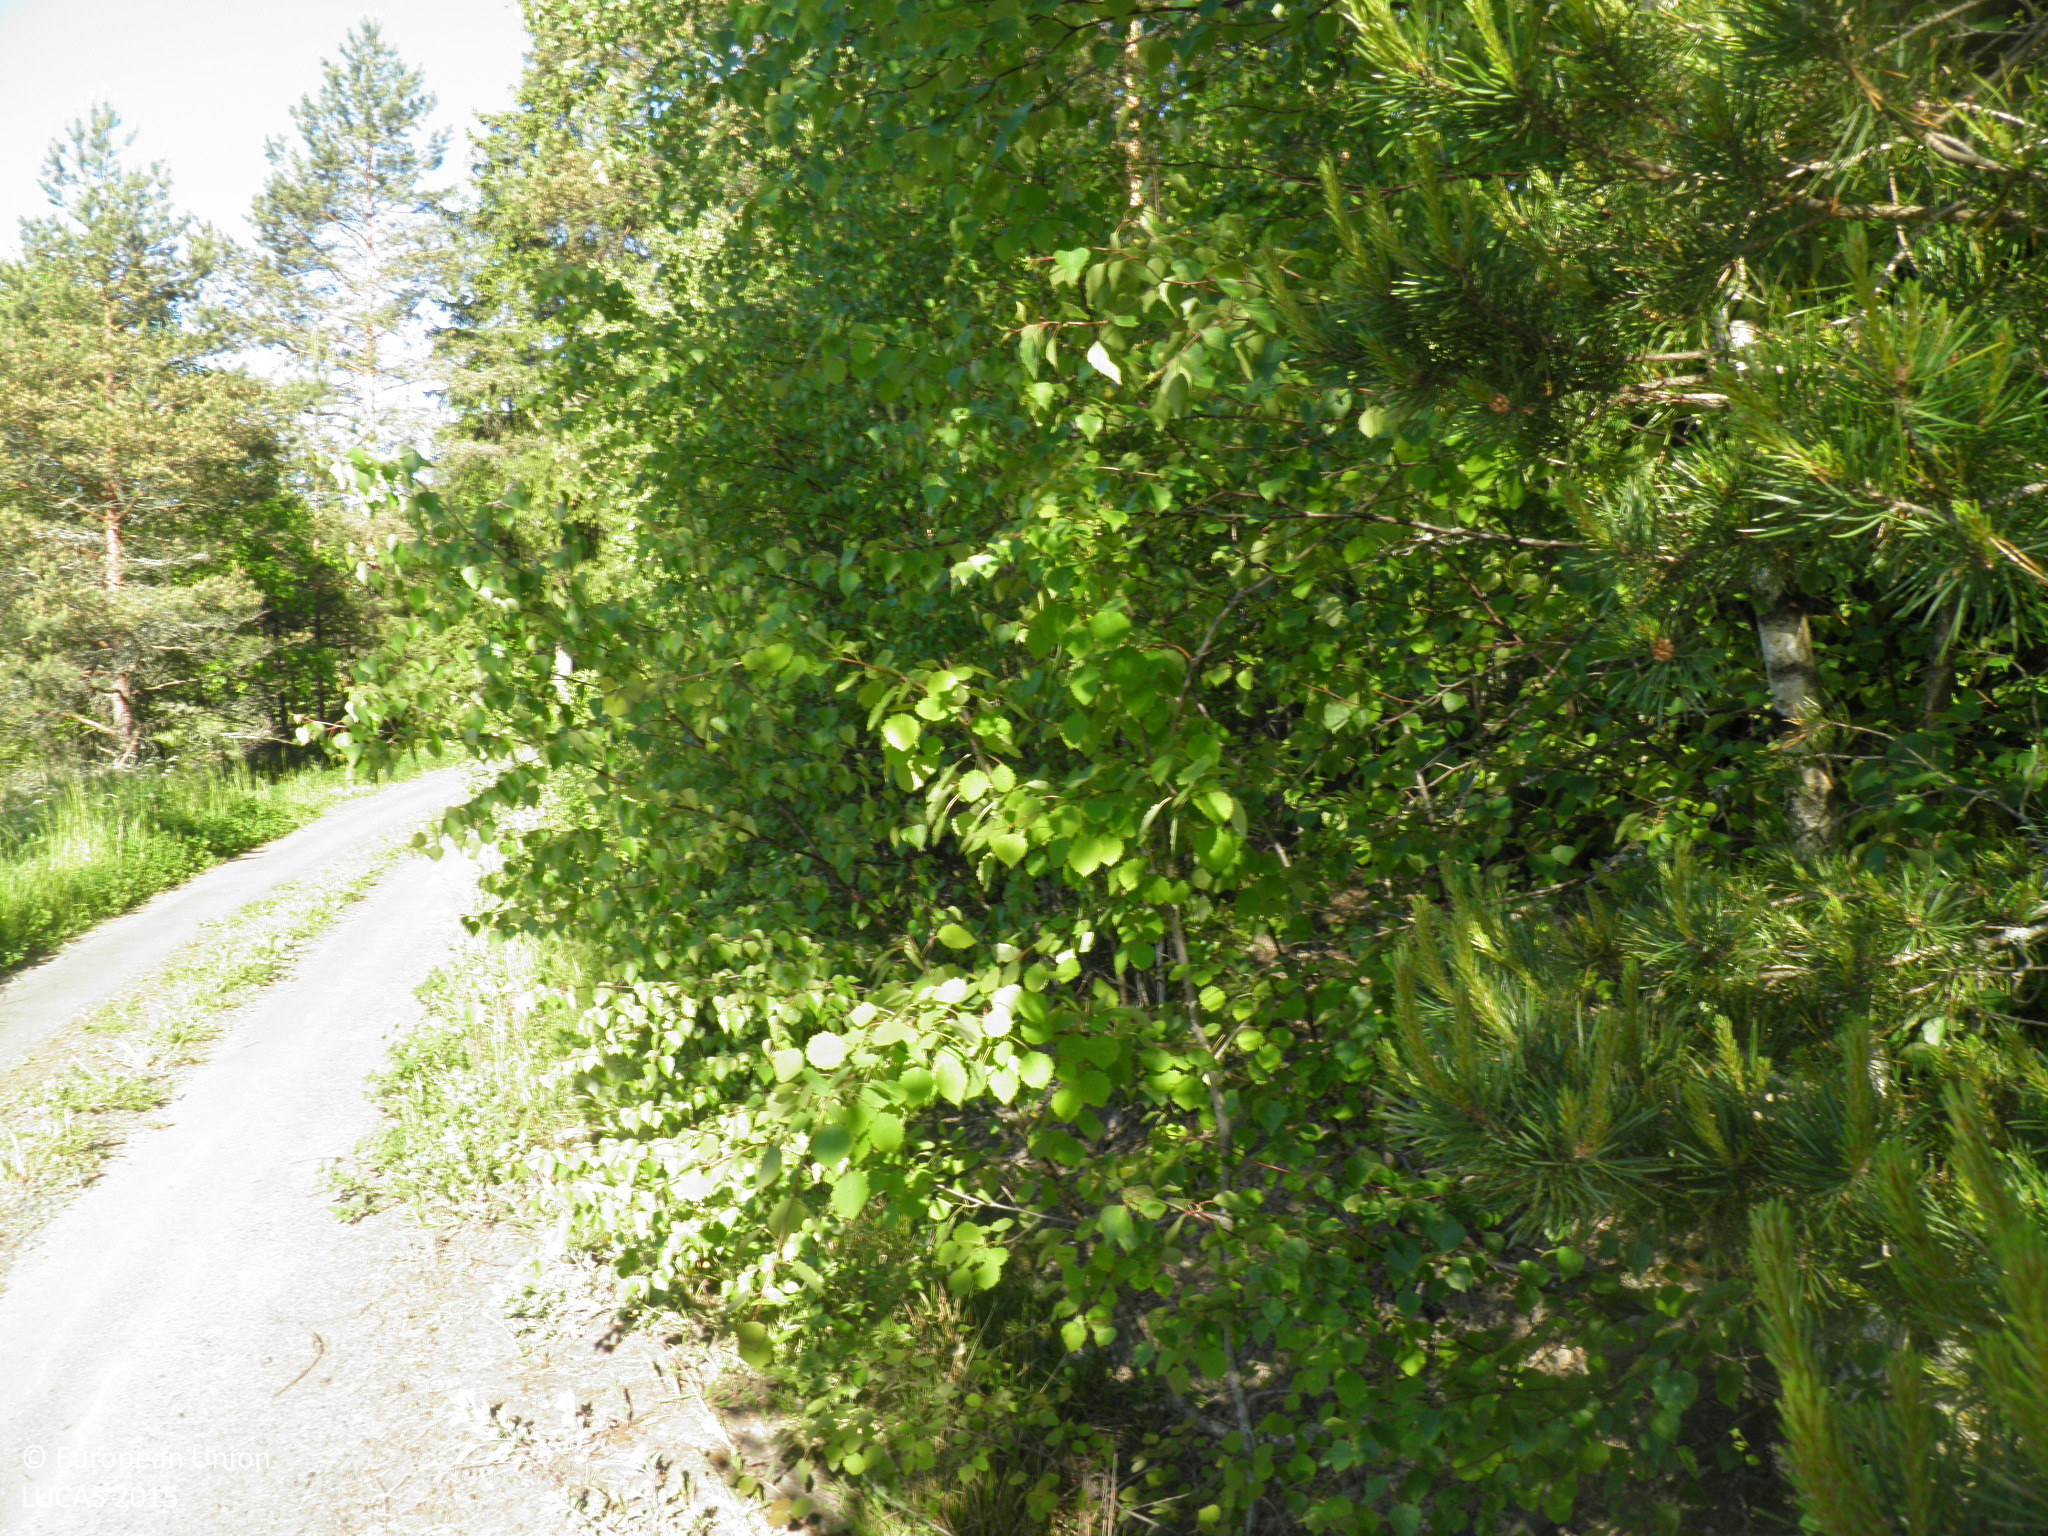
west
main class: Woodland
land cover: Pine dominated coniferous woodland
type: boreal forest
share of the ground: > 75 %
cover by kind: coniferous forest trees 70 %, broadleaved forest trees 10 %, shrubs 10 %, herbaceous plants 10 %
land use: Forestry
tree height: > 5 m
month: June
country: FI
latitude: 60.4035
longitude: 22.5416
